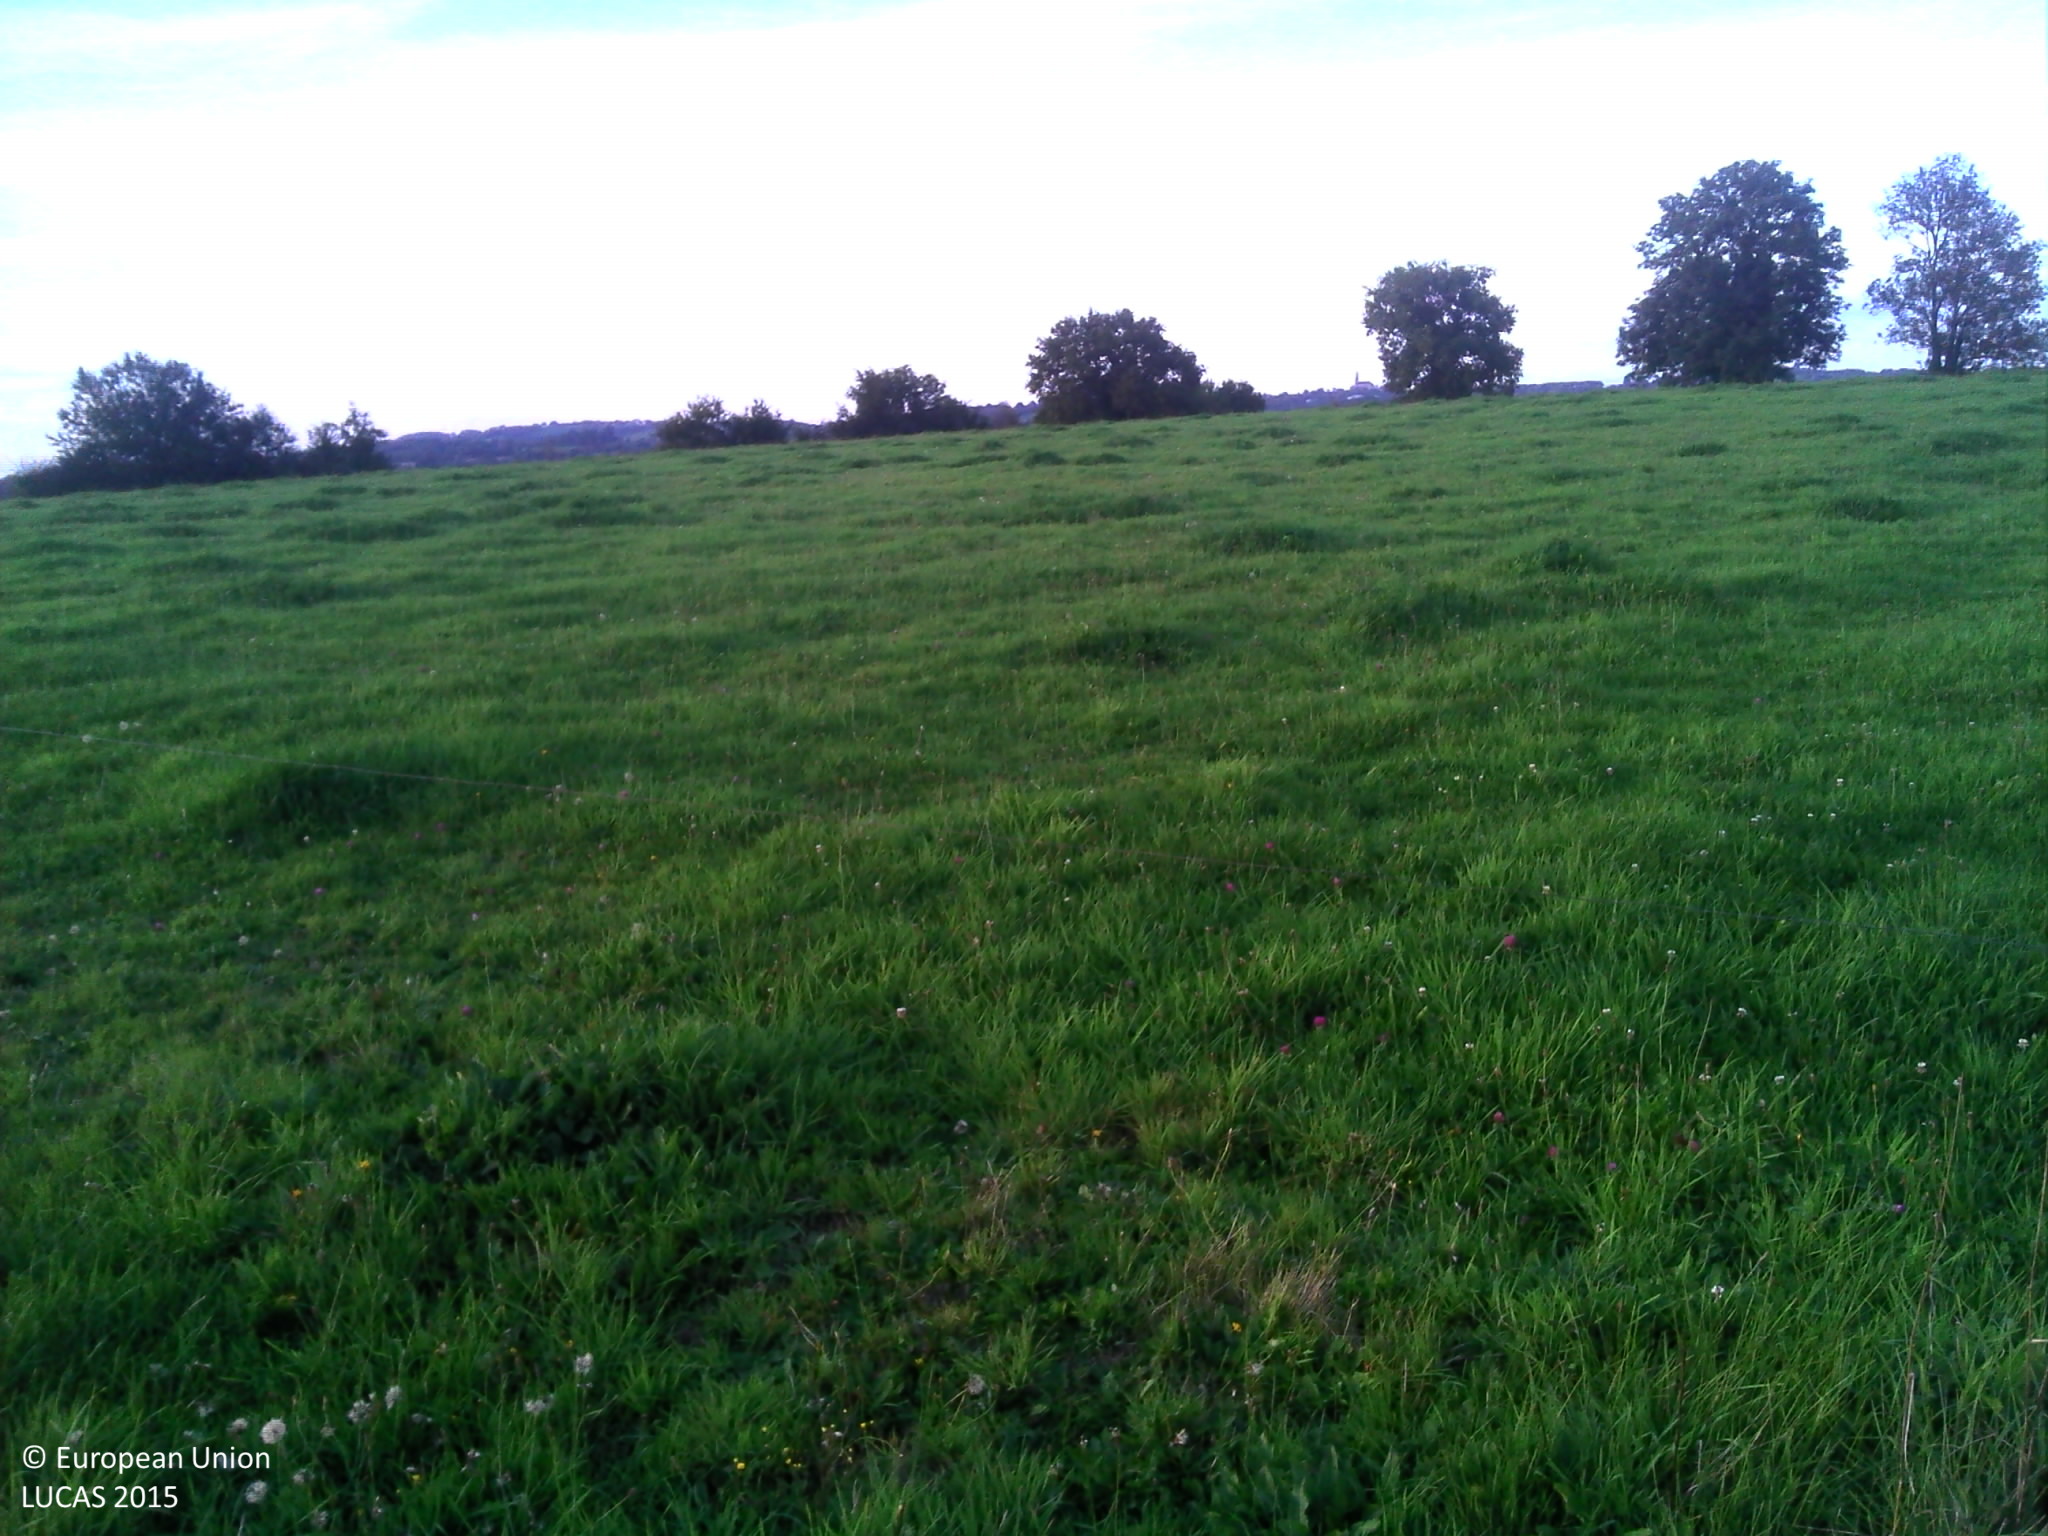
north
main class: Grassland
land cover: Grassland without tree/shrub cover
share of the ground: > 75 %
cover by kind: herbaceous plants 100 %
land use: Agriculture (excluding fallow land and kitchen gardens)
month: September
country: FR
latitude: 46.7923
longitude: -0.8925
